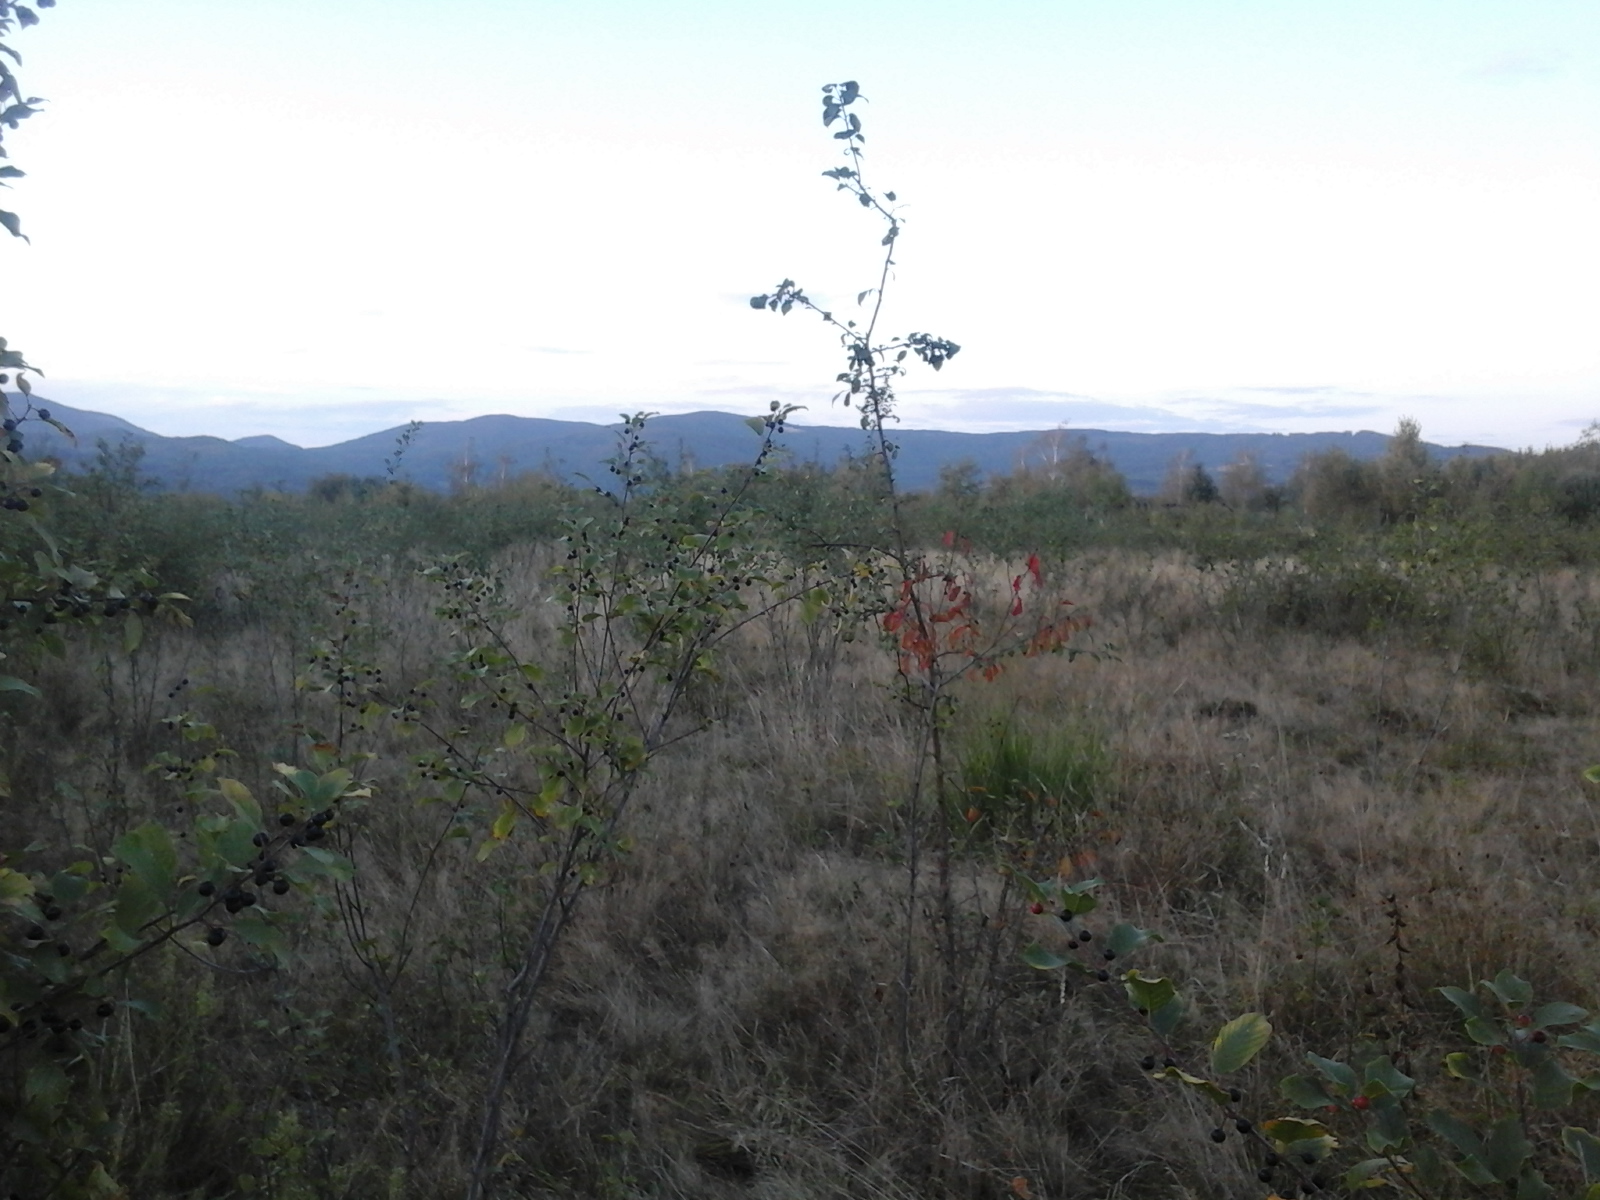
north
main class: Shrubland
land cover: Shrubland with sparse tree cover
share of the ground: > 75 %
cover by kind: shrubs 95 %, broadleaved forest trees 5 %
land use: Semi-natural and natural areas not in use
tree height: > 5 m
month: September
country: RO
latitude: 47.9066
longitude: 23.4402
